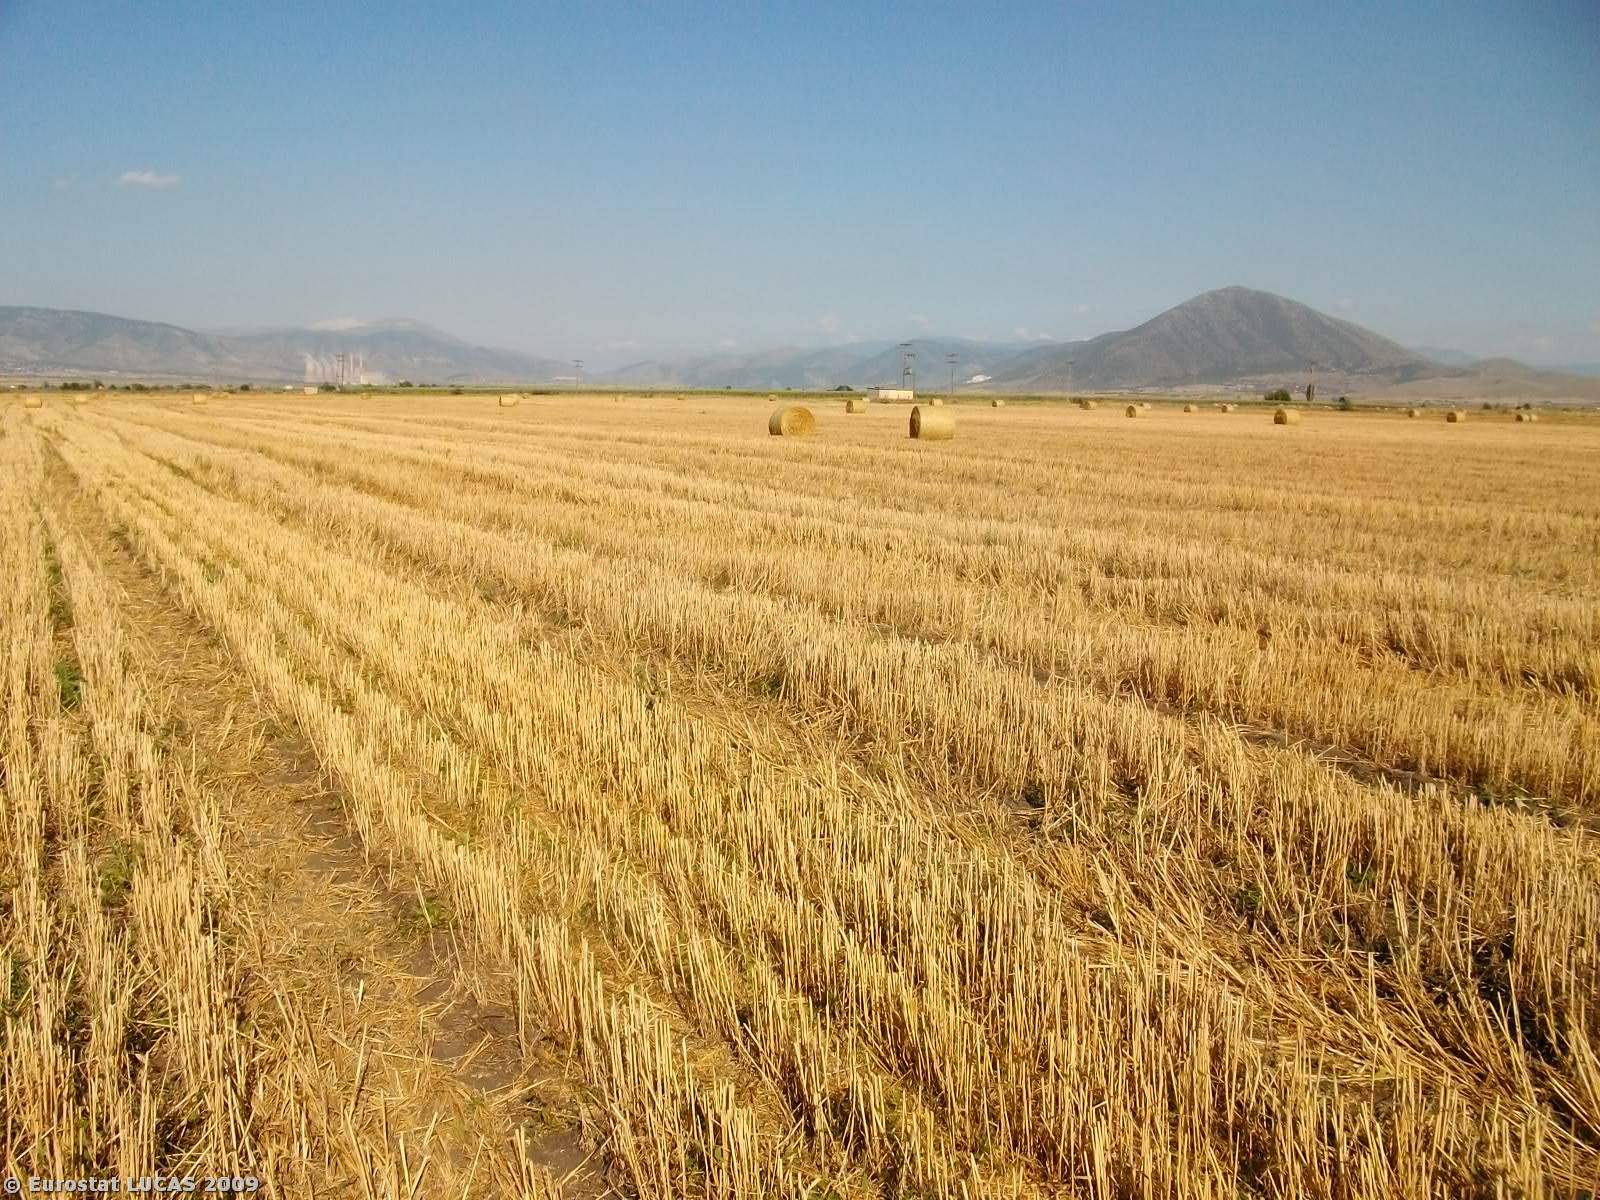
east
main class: Cropland
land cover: Durum wheat
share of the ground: < 10 %
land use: Agriculture (excluding fallow land and kitchen gardens)
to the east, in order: Durum wheat
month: July
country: GR
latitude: 40.3915
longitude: 21.8092
